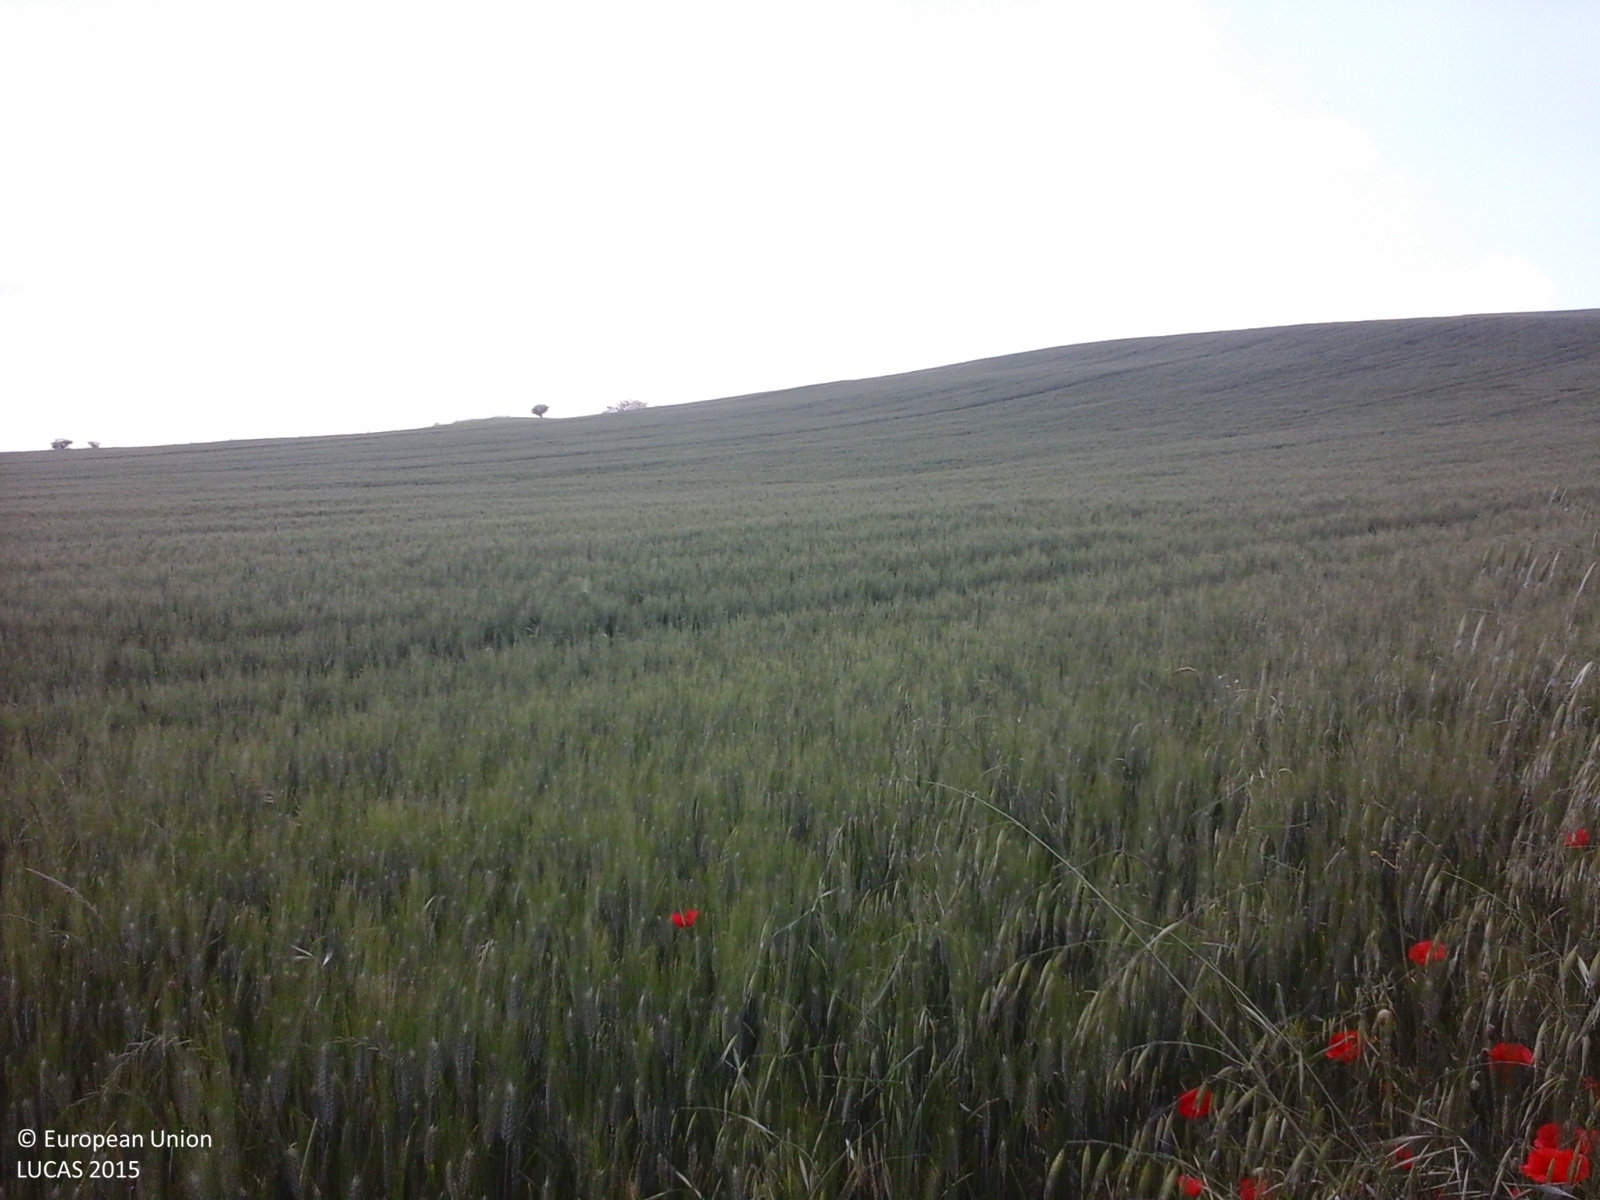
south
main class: Cropland
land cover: Durum wheat
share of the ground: > 75 %
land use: Agriculture (excluding fallow land and kitchen gardens)
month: May
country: IT
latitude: 41.2390
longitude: 15.1242
